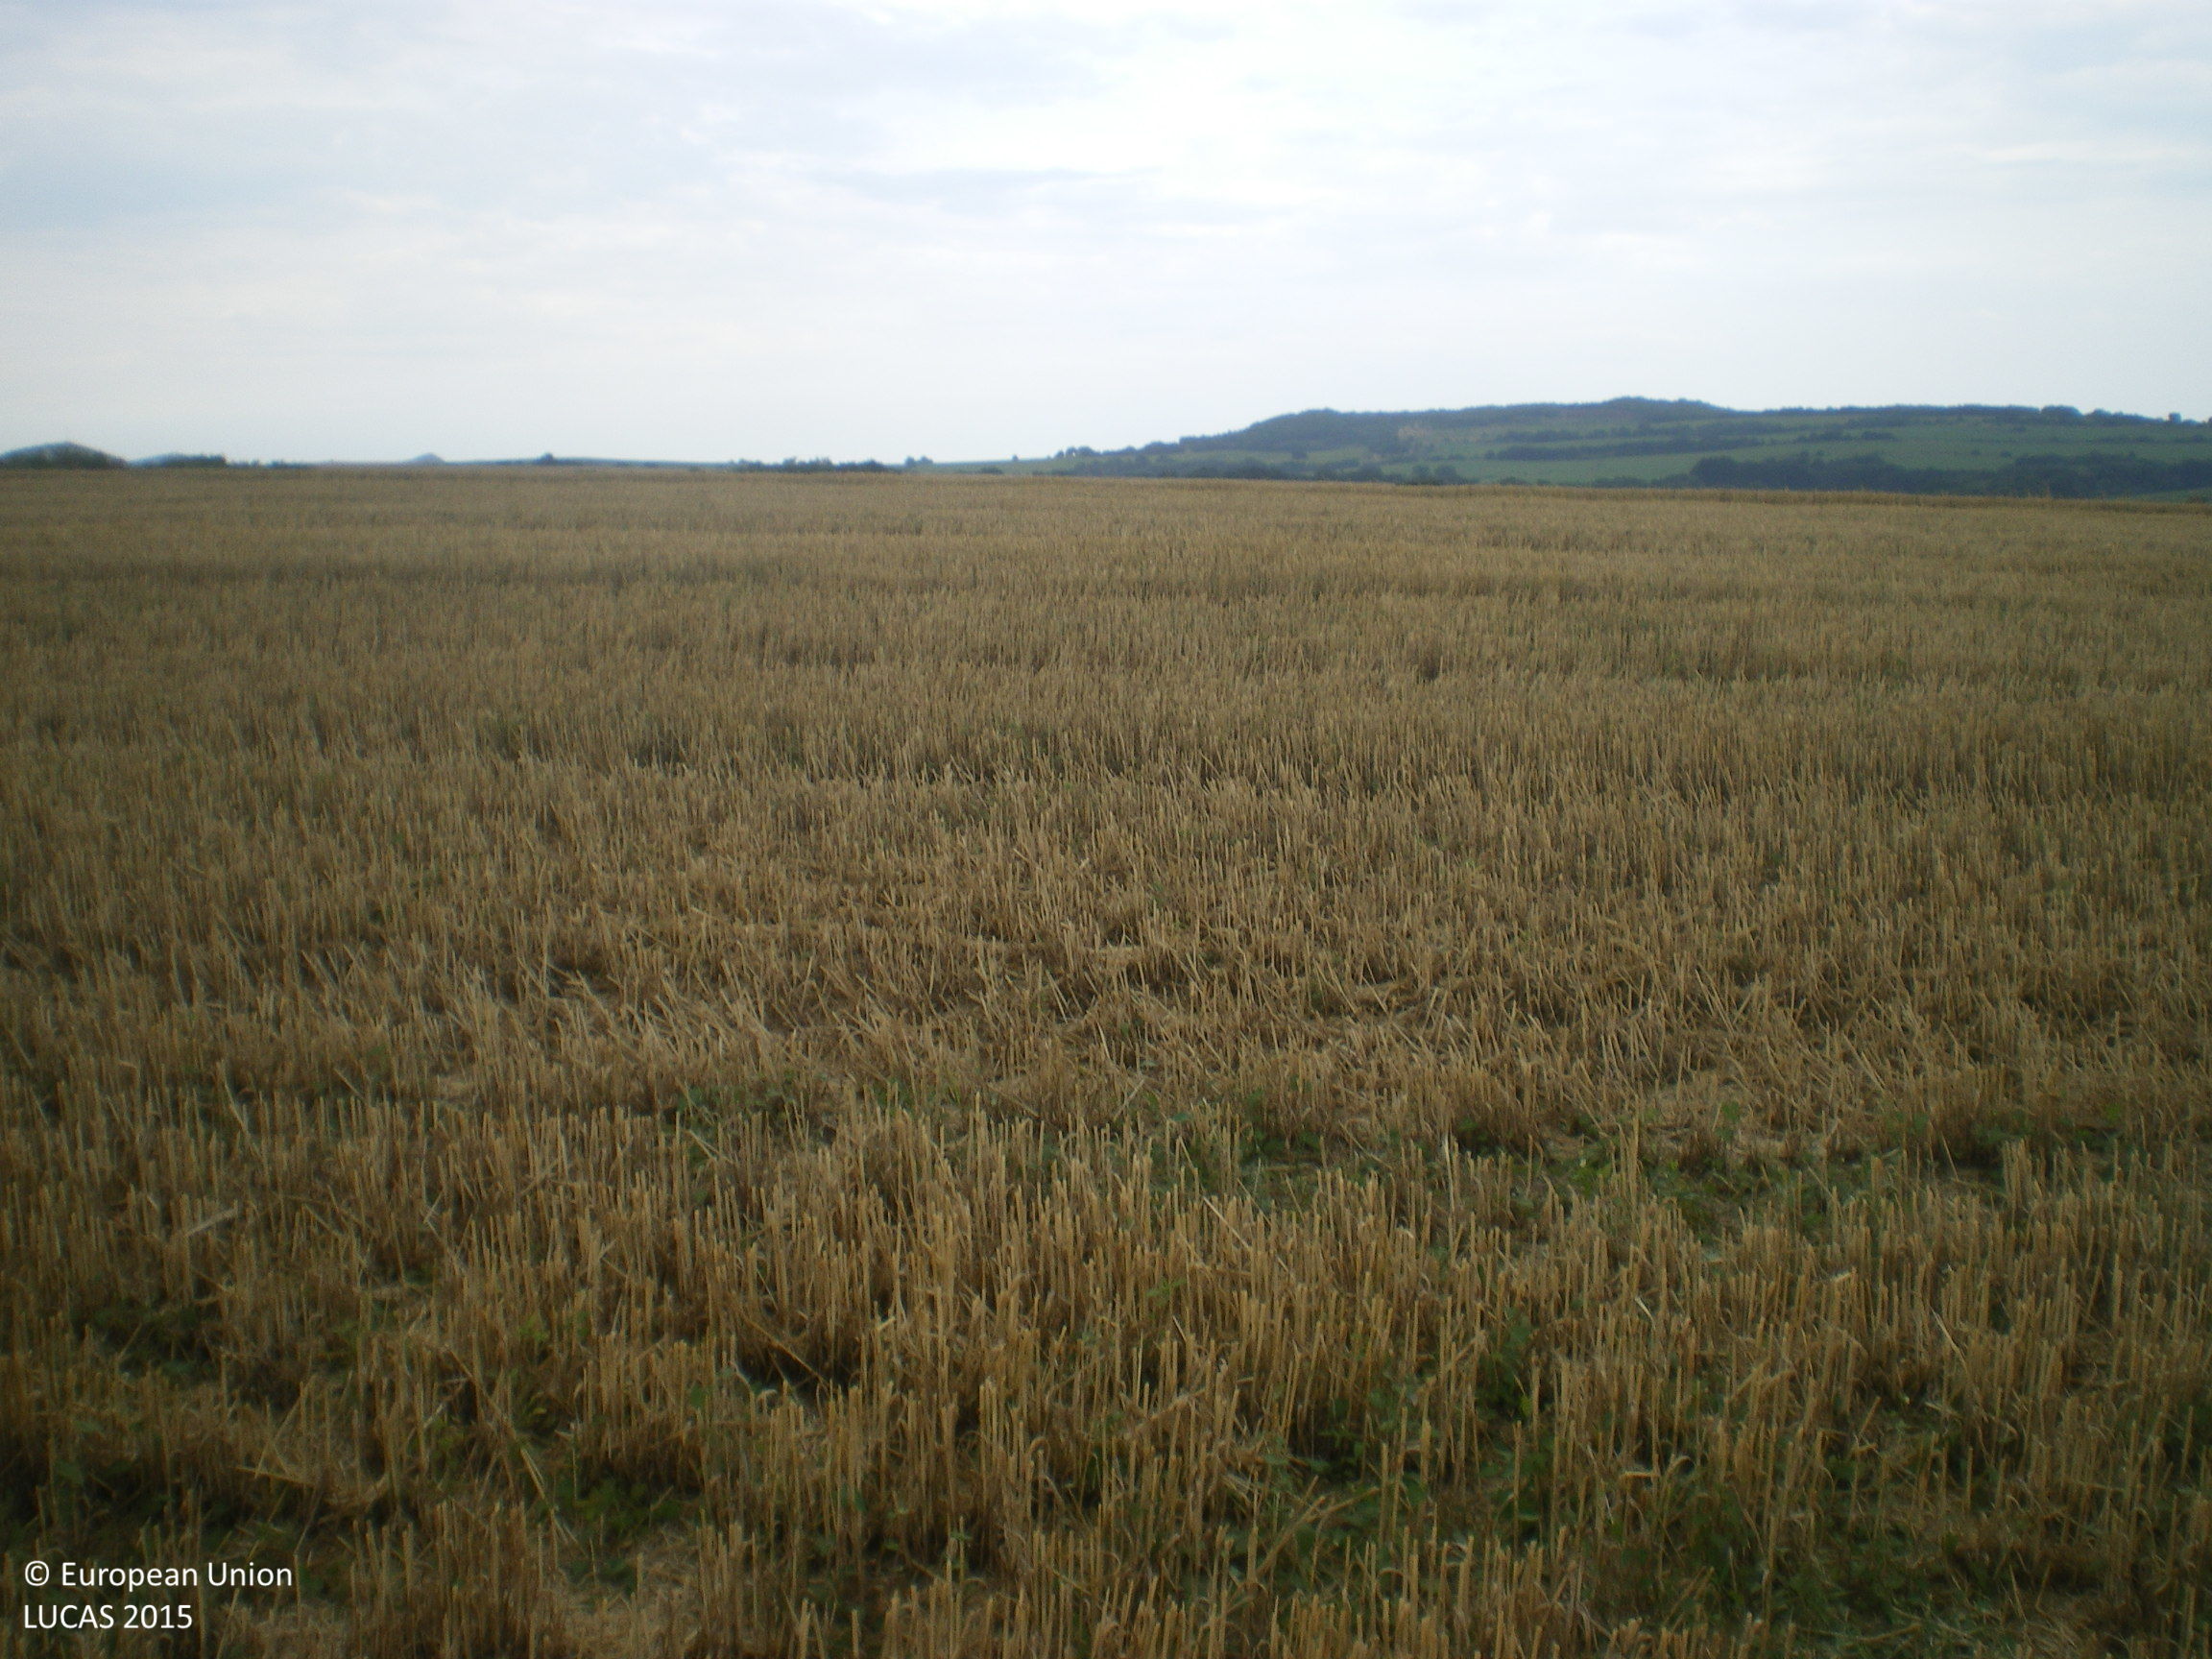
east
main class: Cropland
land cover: Common wheat
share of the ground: < 10 %
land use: Agriculture (excluding fallow land and kitchen gardens)
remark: Harvested field
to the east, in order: Common wheat; Broadleaved woodland; Common wheat
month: July
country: BG
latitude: 42.4028
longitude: 25.2883
